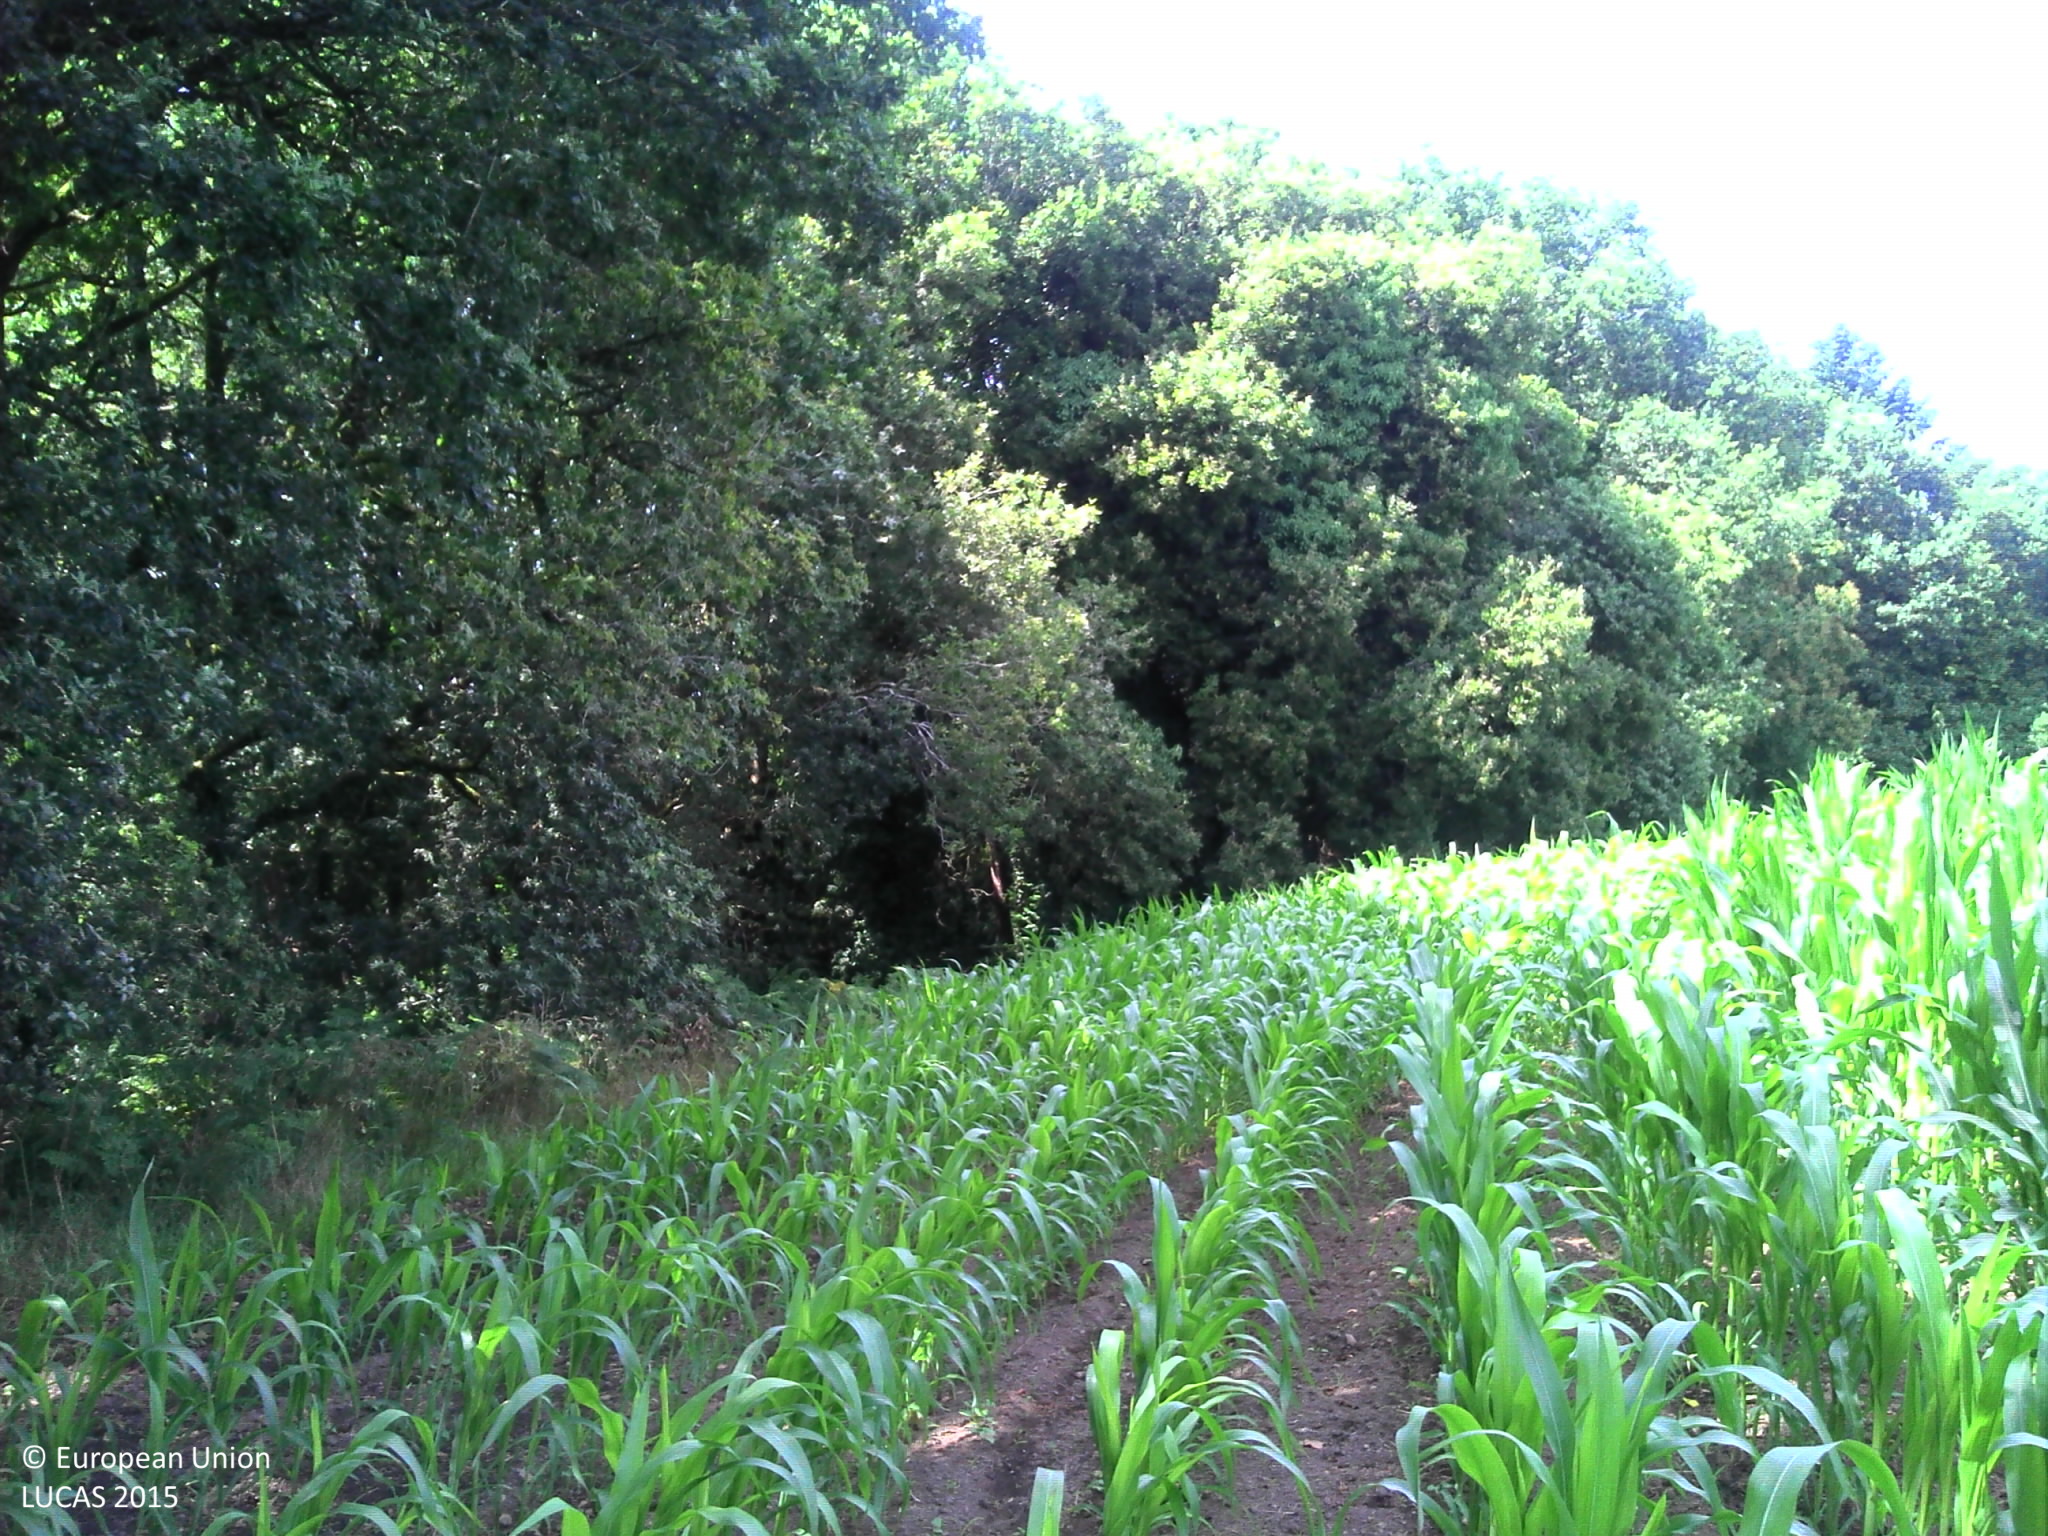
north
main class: Cropland
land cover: Maize
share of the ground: > 75 %
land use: Agriculture (excluding fallow land and kitchen gardens)
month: July
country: FR
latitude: 48.0255
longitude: -3.0624
